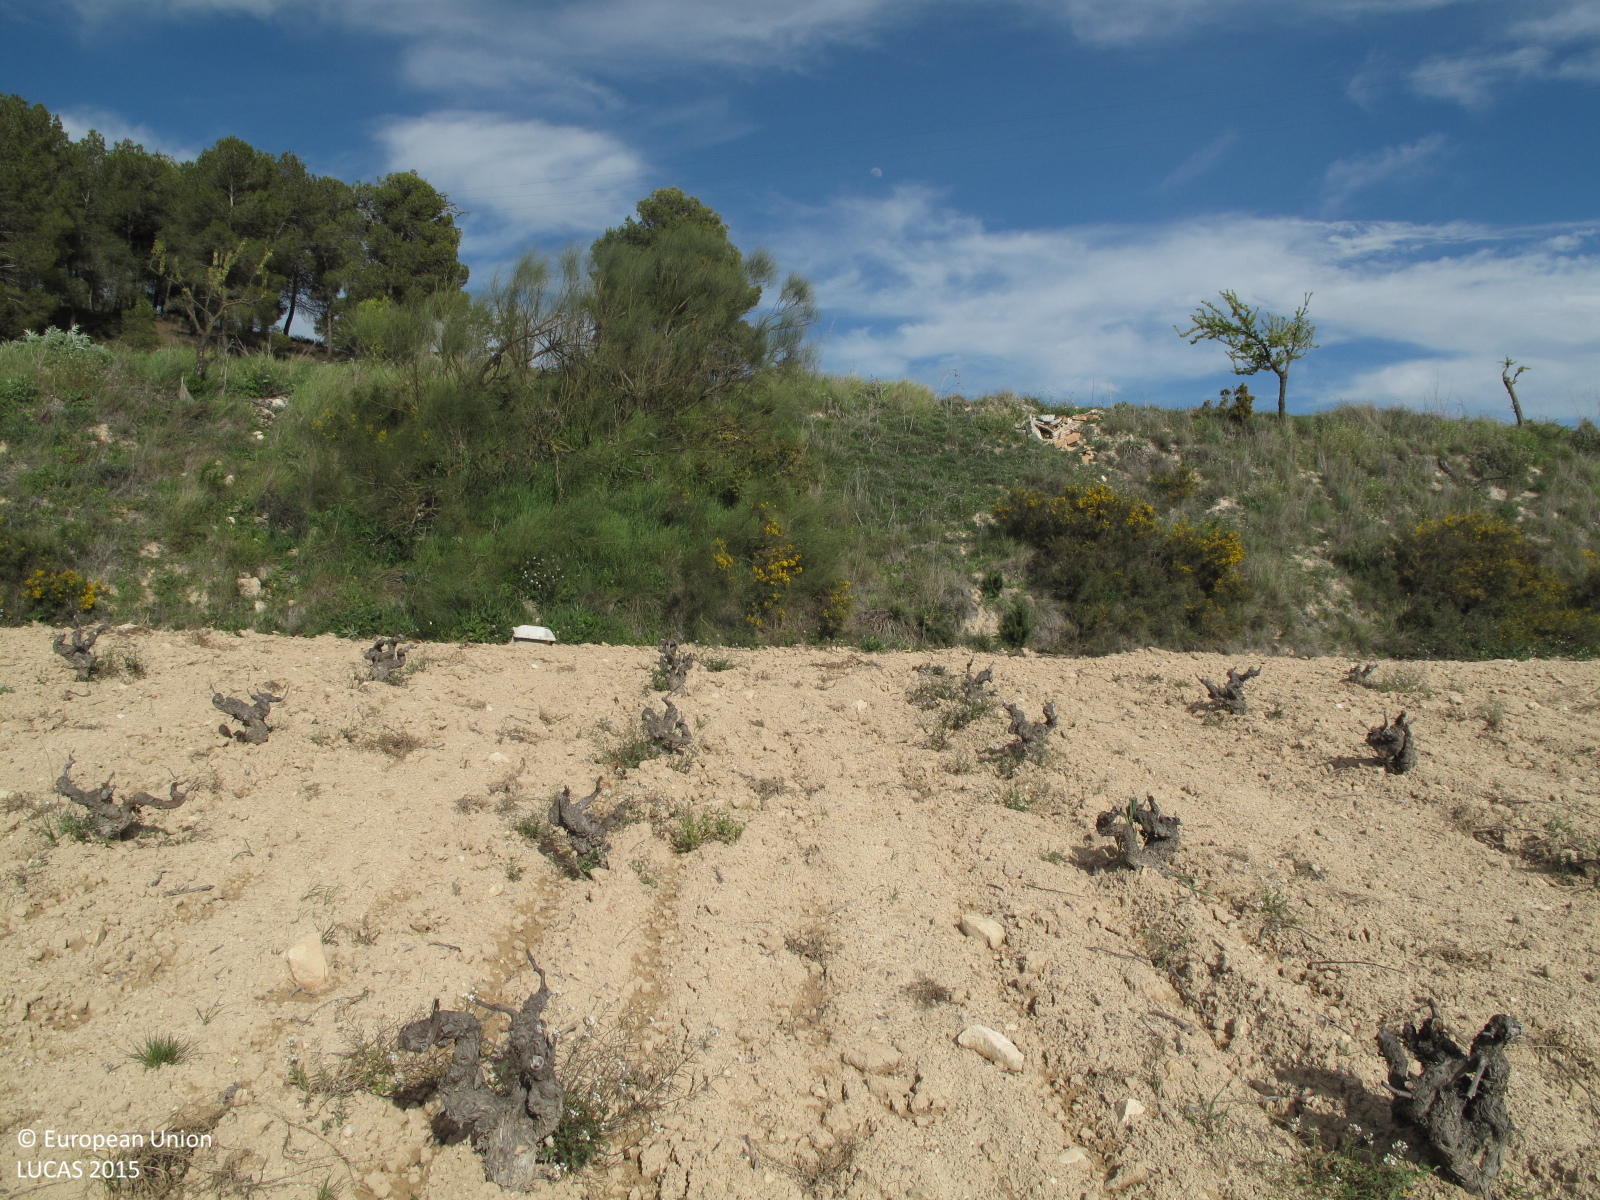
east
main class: Cropland
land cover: Vineyards
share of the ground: < 10 %
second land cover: Other bare soil
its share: > 75 %
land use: Agriculture (excluding fallow land and kitchen gardens)
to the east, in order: Vineyards; Other bare soil; Electric lines; Grassland with sparse tree/shrub cover; Vineyards; Electric lines; Vineyards; Single bushes/trees; Other bare soil; Grass margins; Tracks; Single bushes/trees; Grass margins; Other bare soil
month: March
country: ES
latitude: 38.7956
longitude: -0.7800
